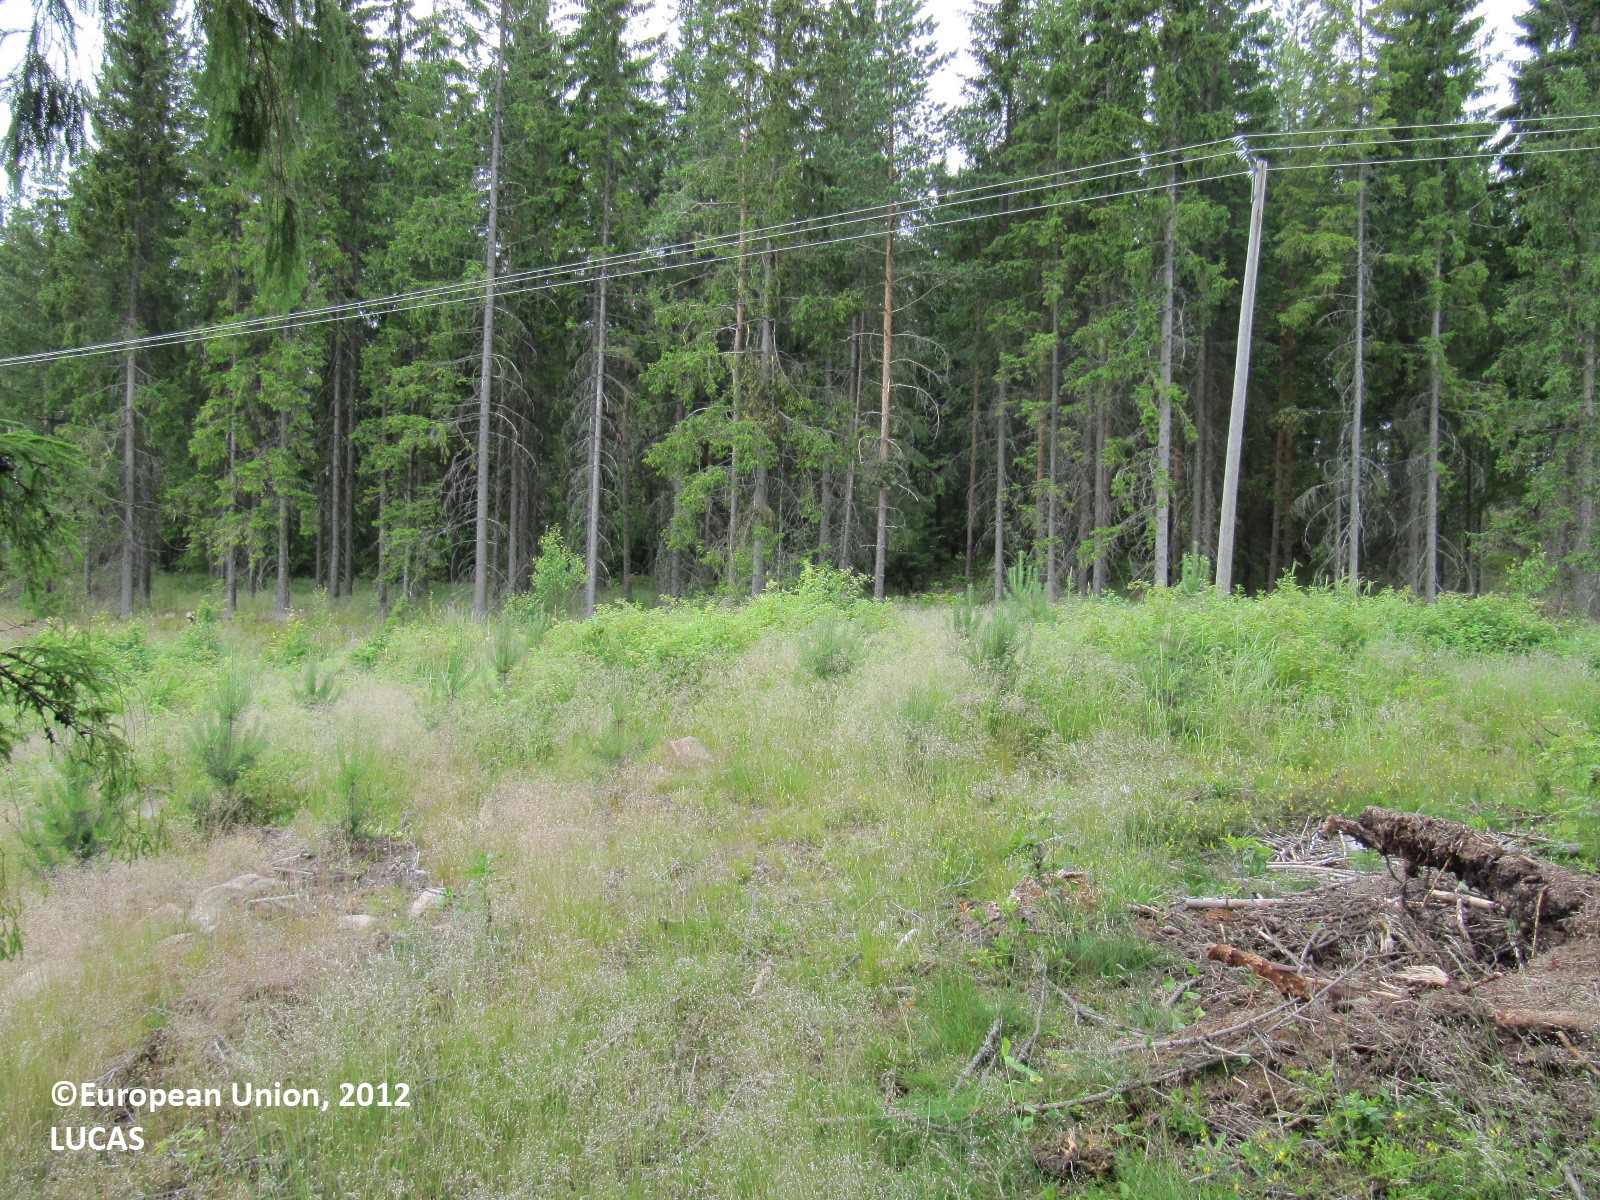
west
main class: Woodland
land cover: Spruce dominated coniferous woodland
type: boreal forest
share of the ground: > 75 %
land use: Forestry
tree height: > 5 m
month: July
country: FI
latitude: 60.9444
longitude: 23.4278
